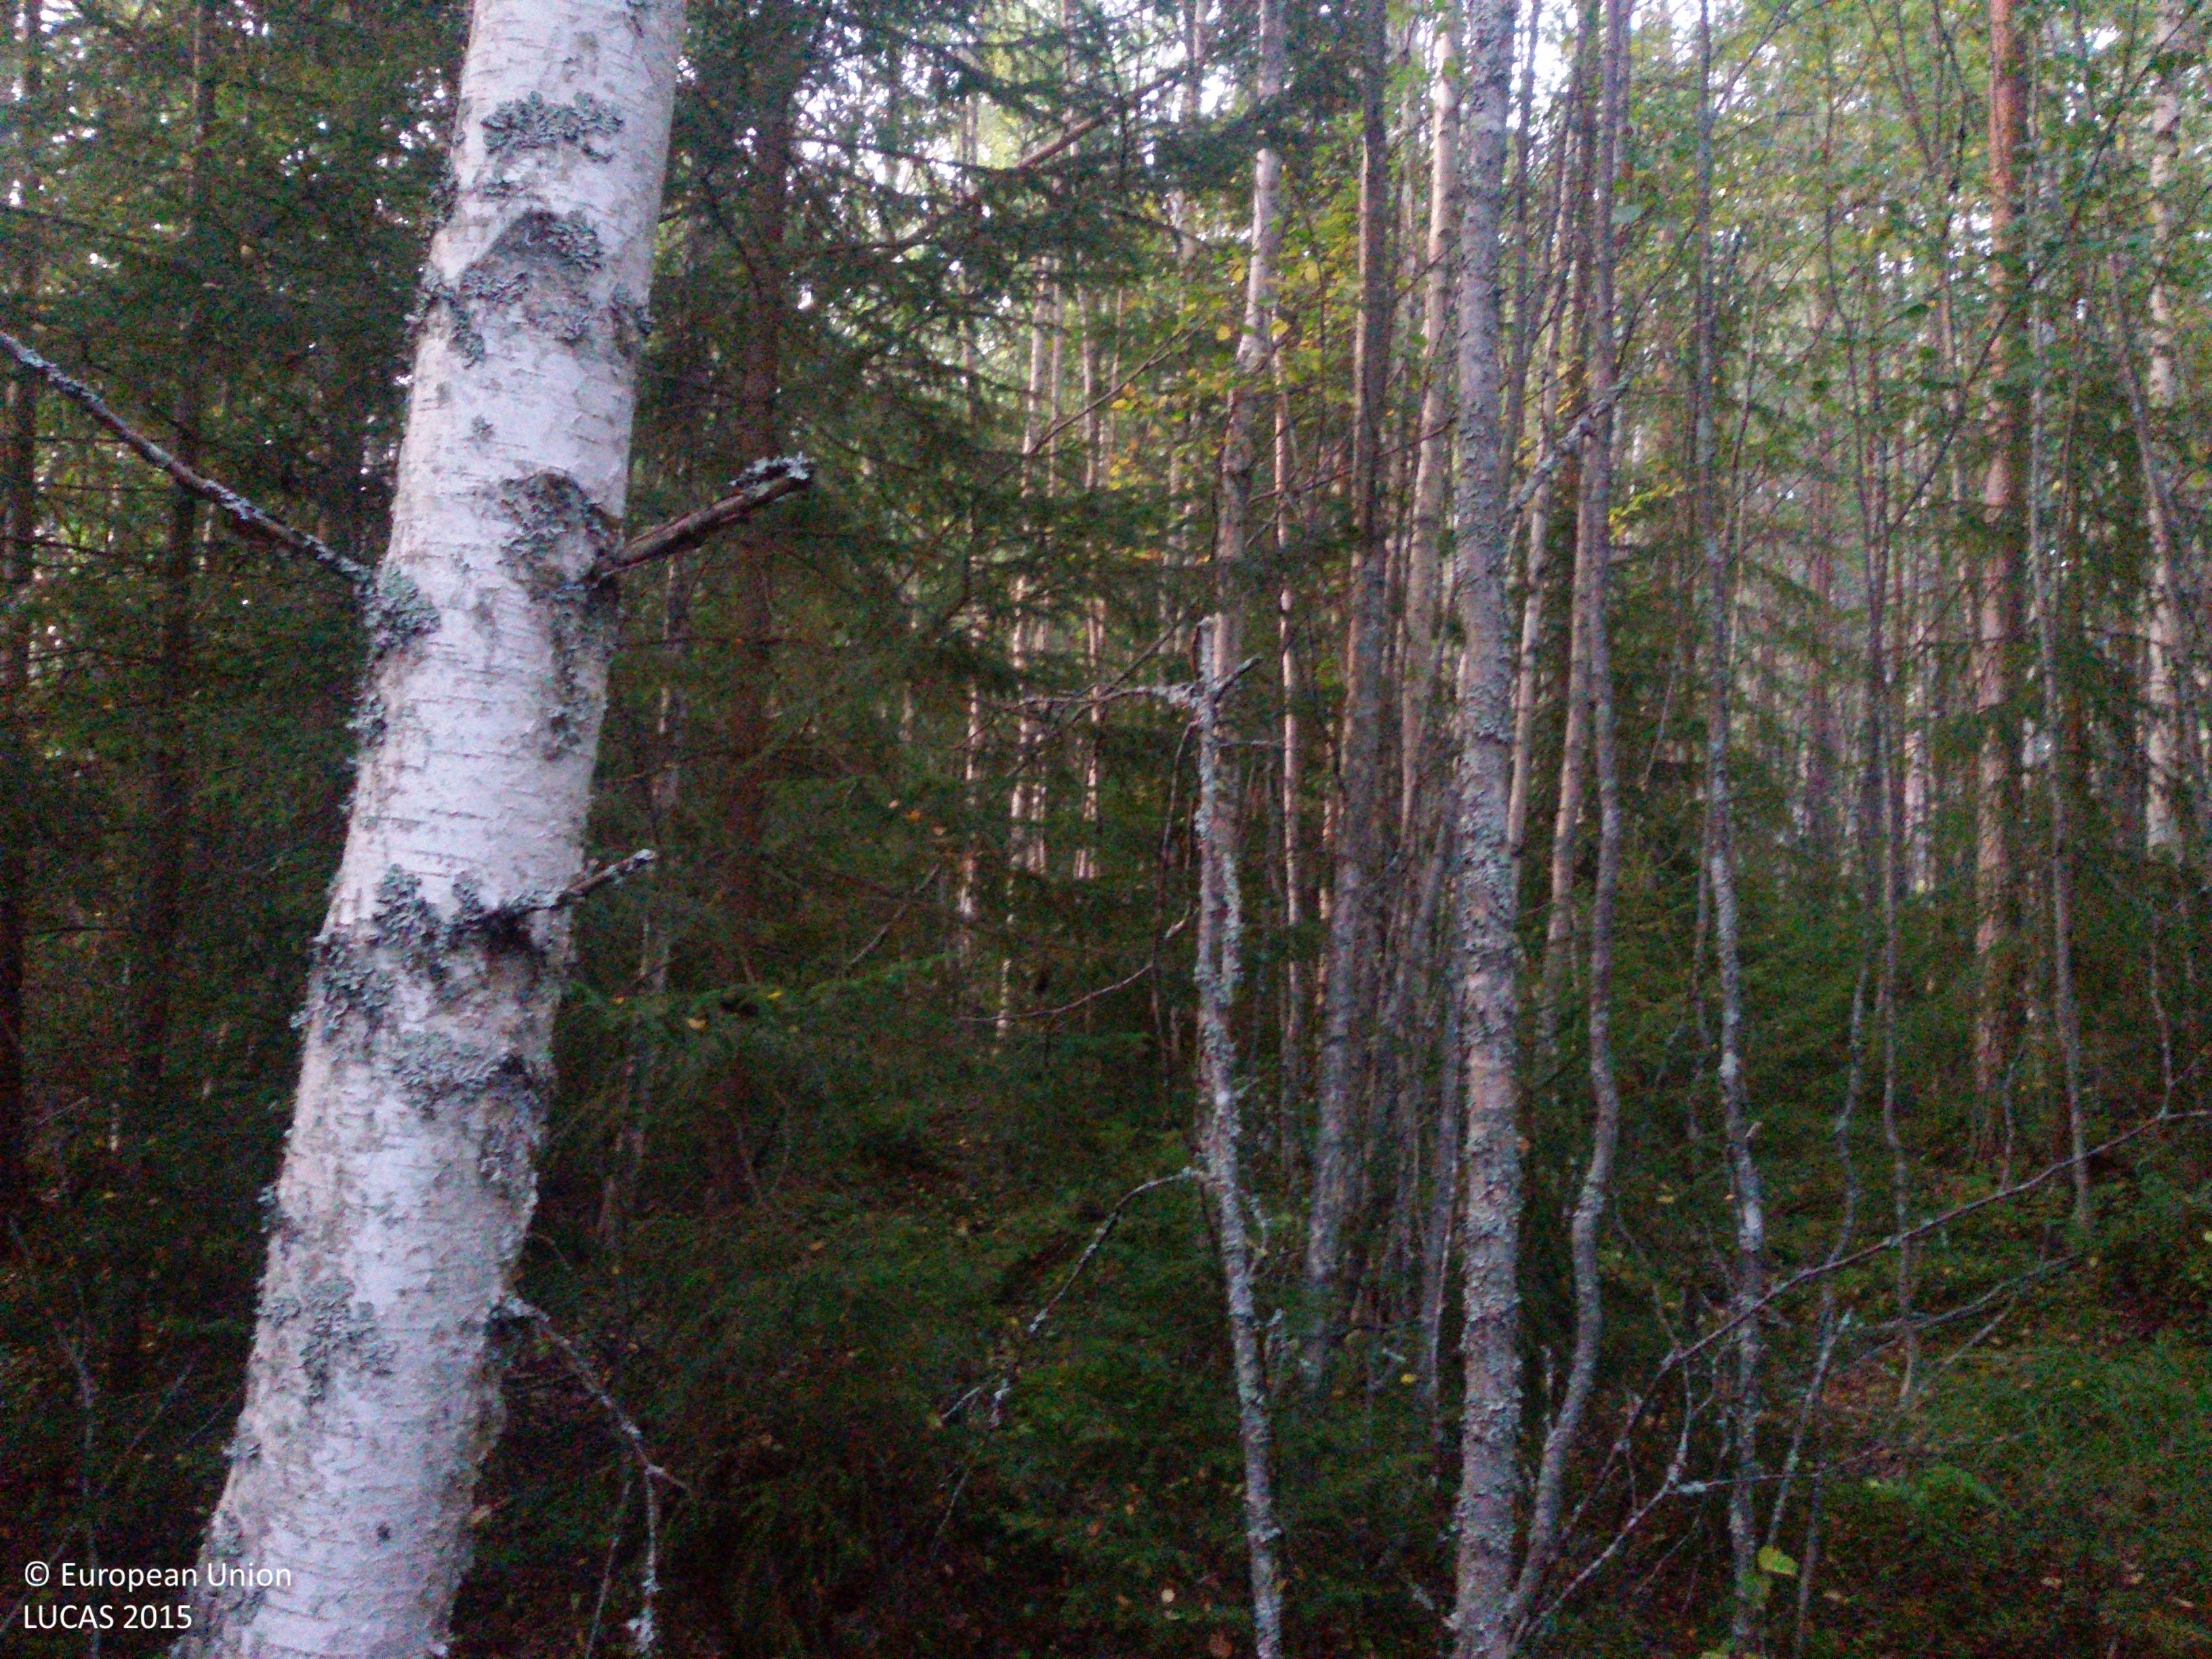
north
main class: Woodland
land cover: Pine dominated mixed woodland
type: boreal forest
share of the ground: > 75 %
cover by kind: coniferous forest trees 40 %, broadleaved forest trees 40 %, herbaceous plants 15 %, lichens and mosses 5 %
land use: Forestry
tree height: > 5 m
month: September
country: SE
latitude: 60.8880
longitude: 14.9432
